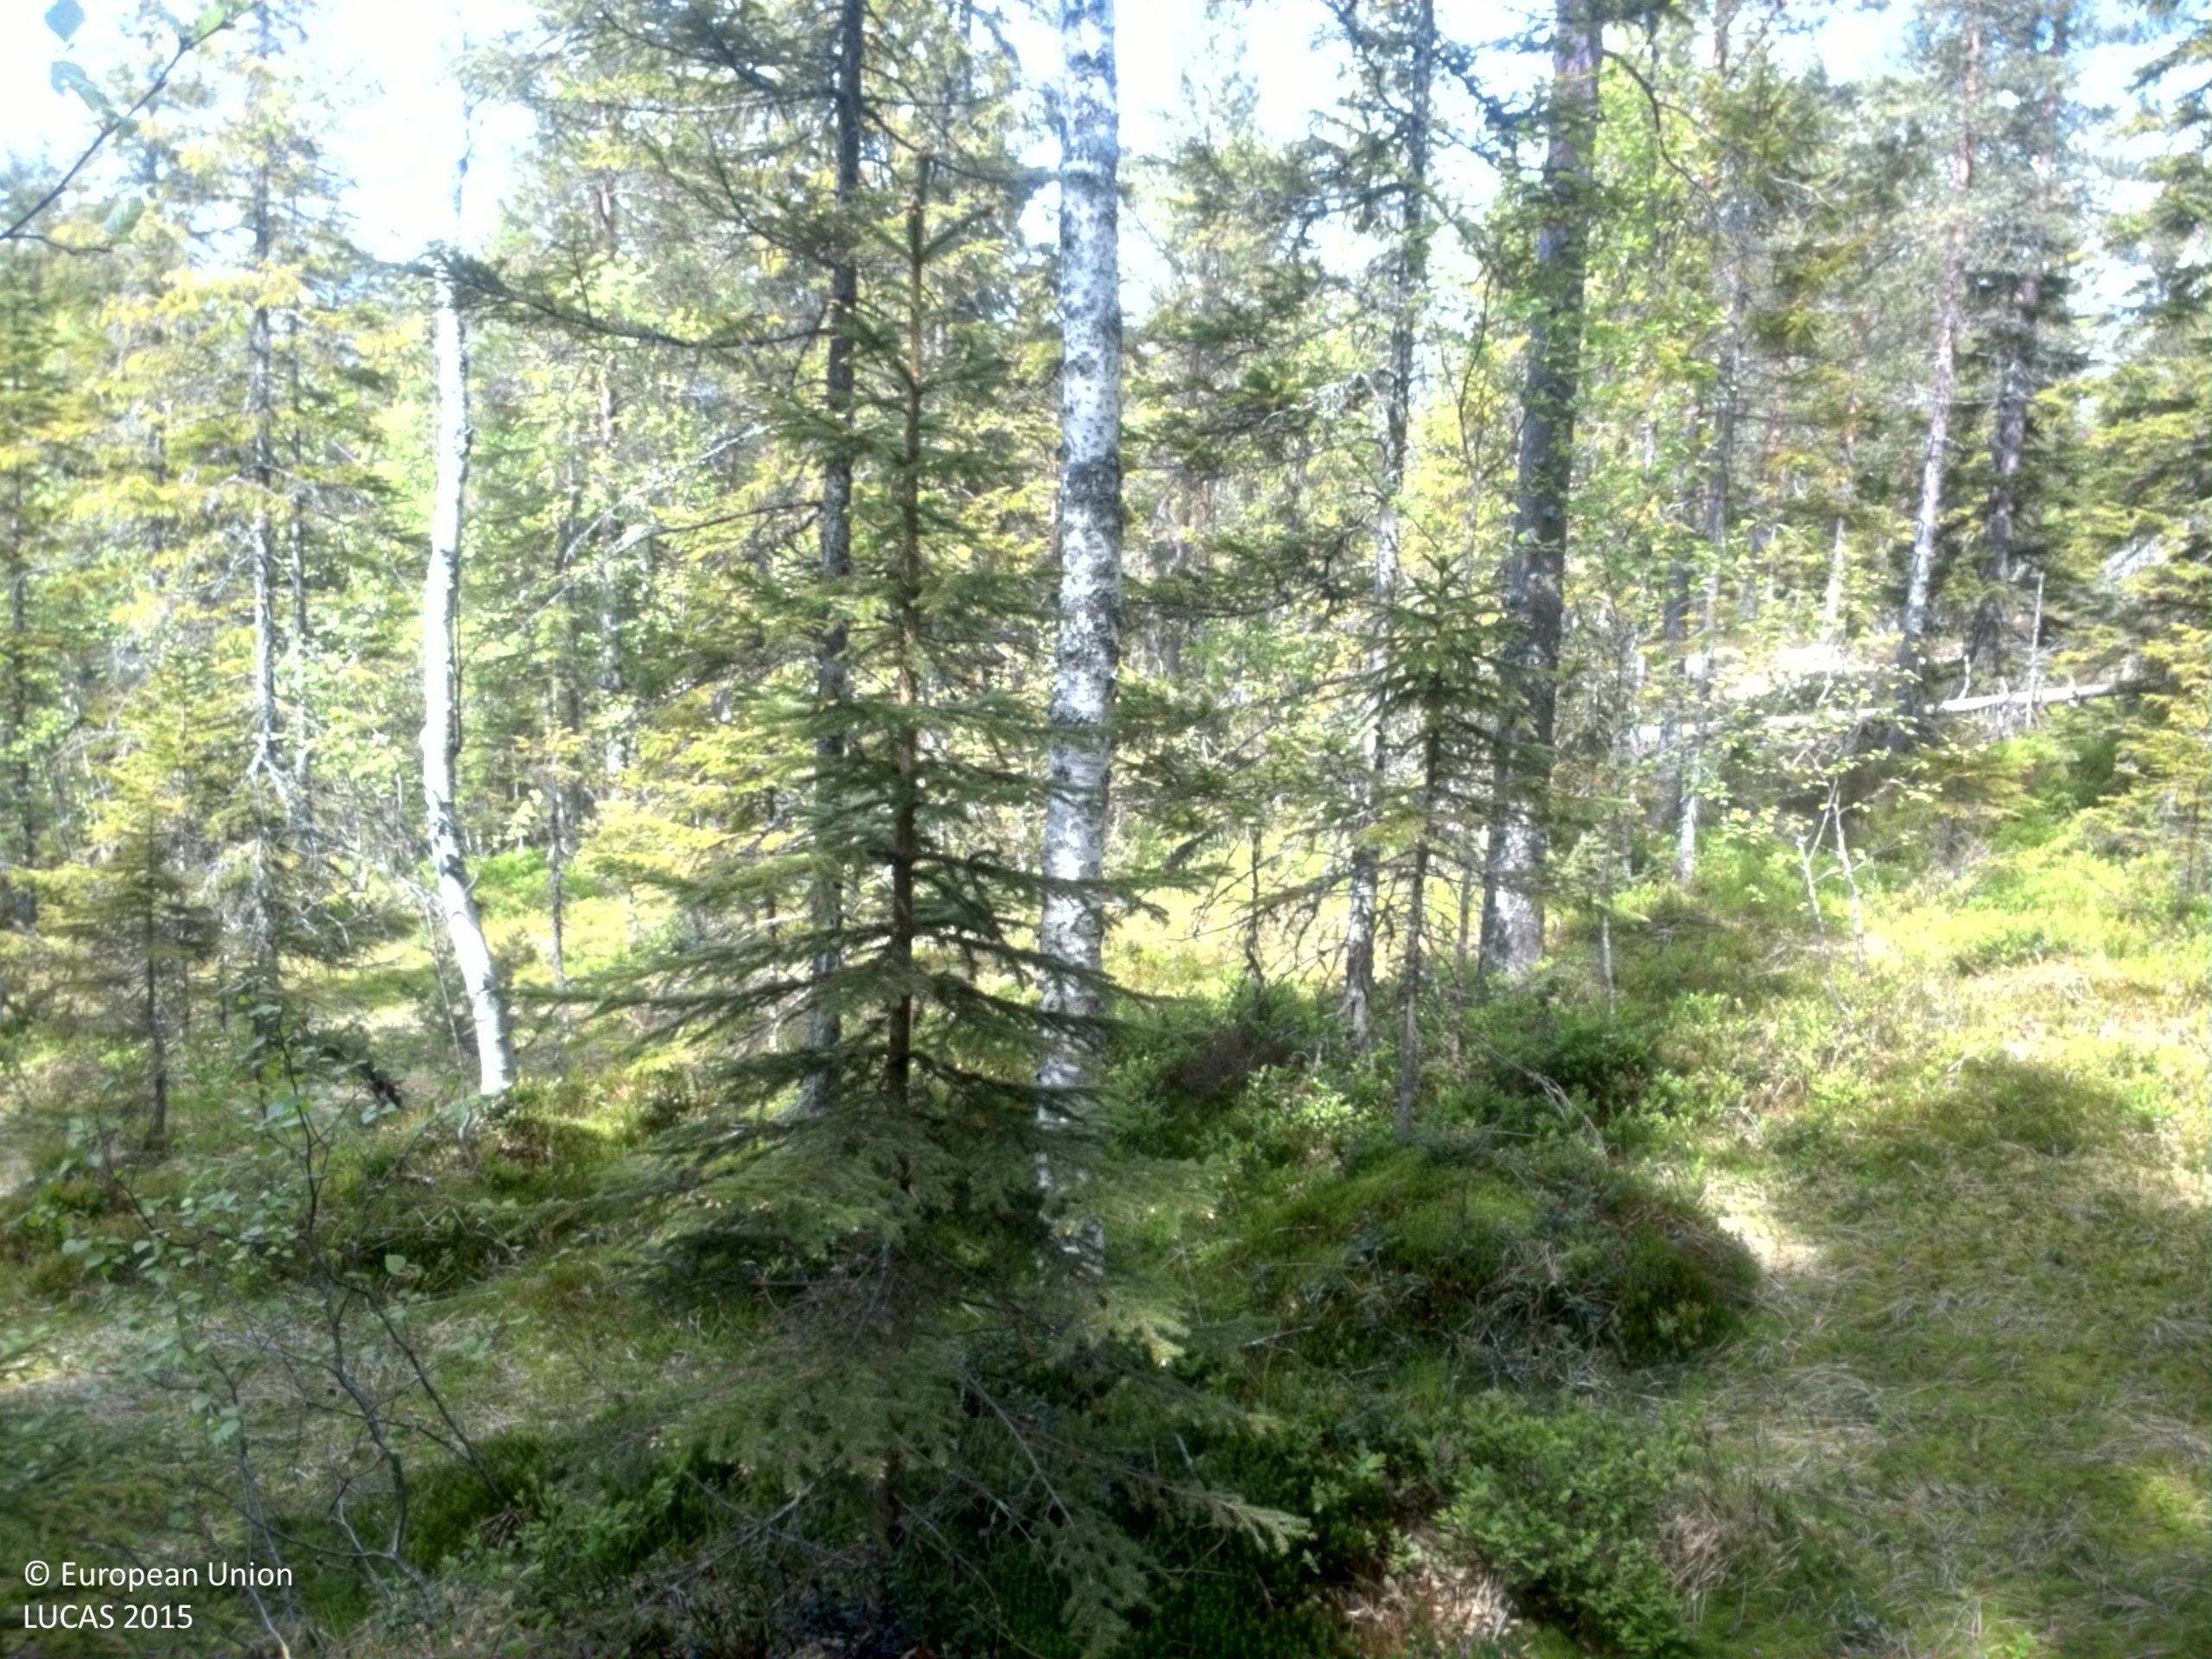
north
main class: Woodland
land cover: Spruce dominated mixed woodland
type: boreal forest
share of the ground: 50 - 75 %
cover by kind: coniferous forest trees 45 %, lichens and mosses 30 %, broadleaved forest trees 15 %, shrubs 10 %
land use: Forestry
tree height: > 5 m
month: June
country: SE
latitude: 62.9080
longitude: 17.9892
